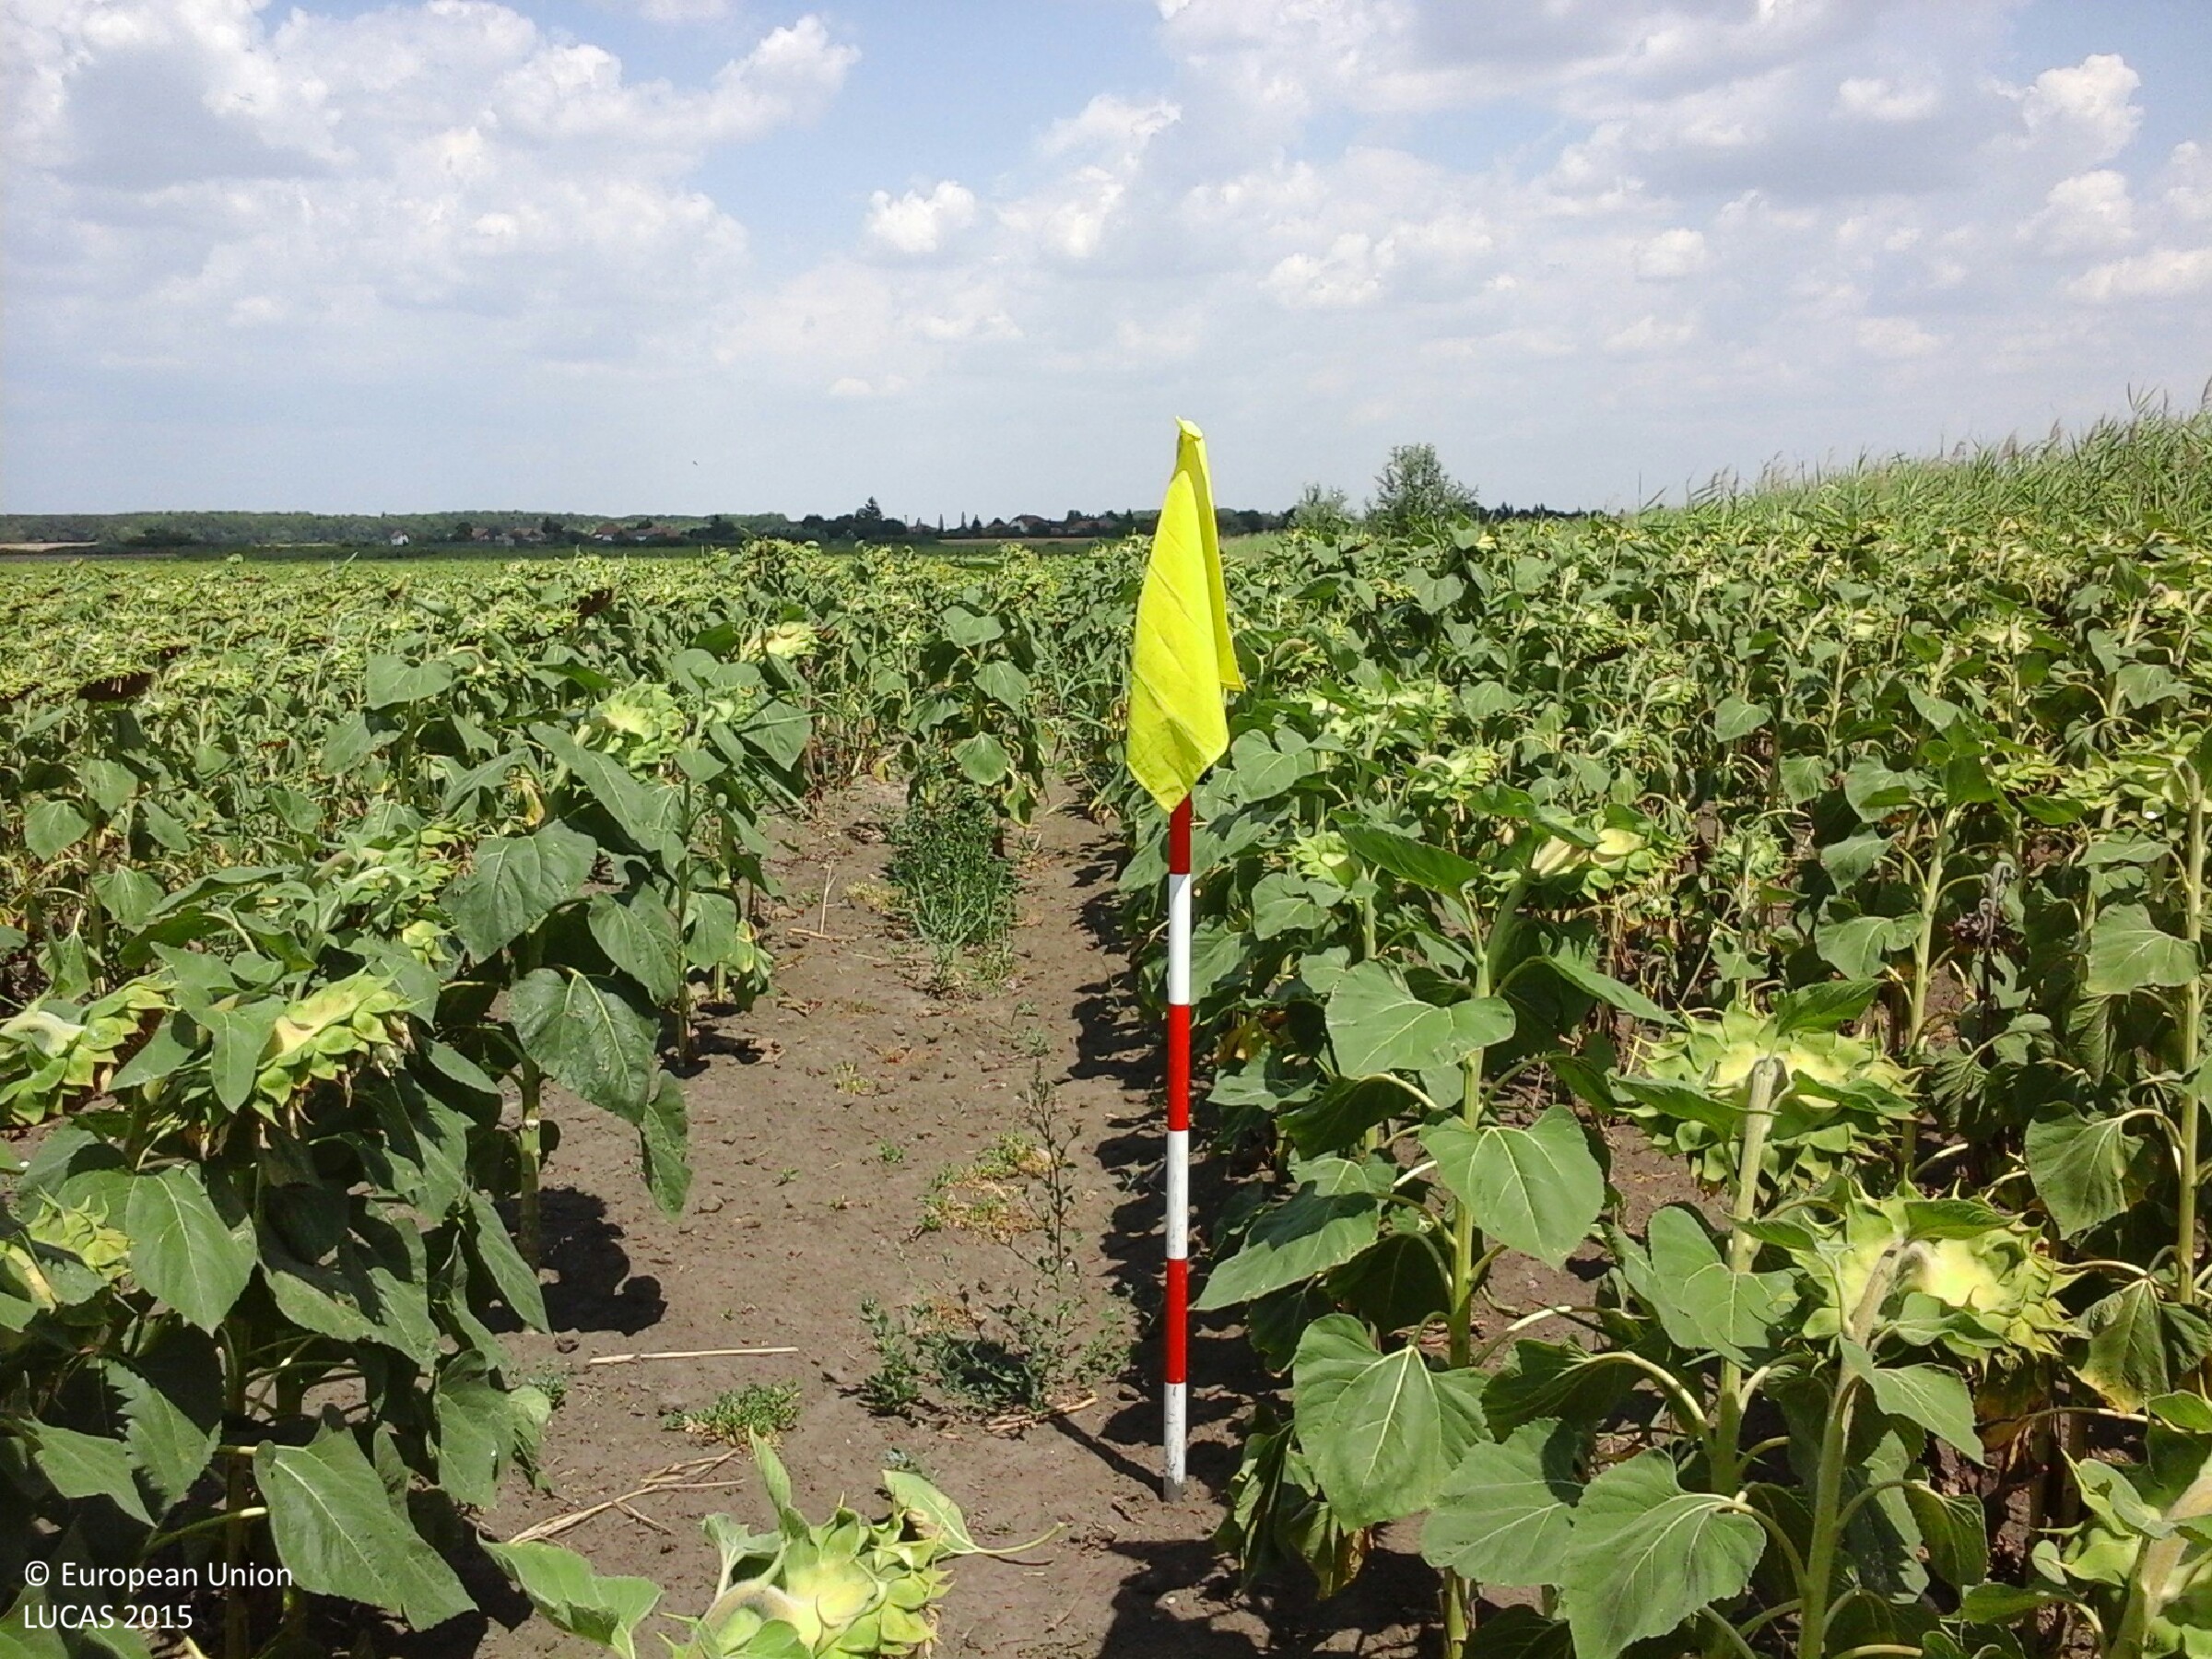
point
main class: Cropland
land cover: Sunflower
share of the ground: > 75 %
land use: Agriculture (excluding fallow land and kitchen gardens)
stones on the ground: < 10 %
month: July
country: HU
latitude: 47.7108
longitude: 20.6025
